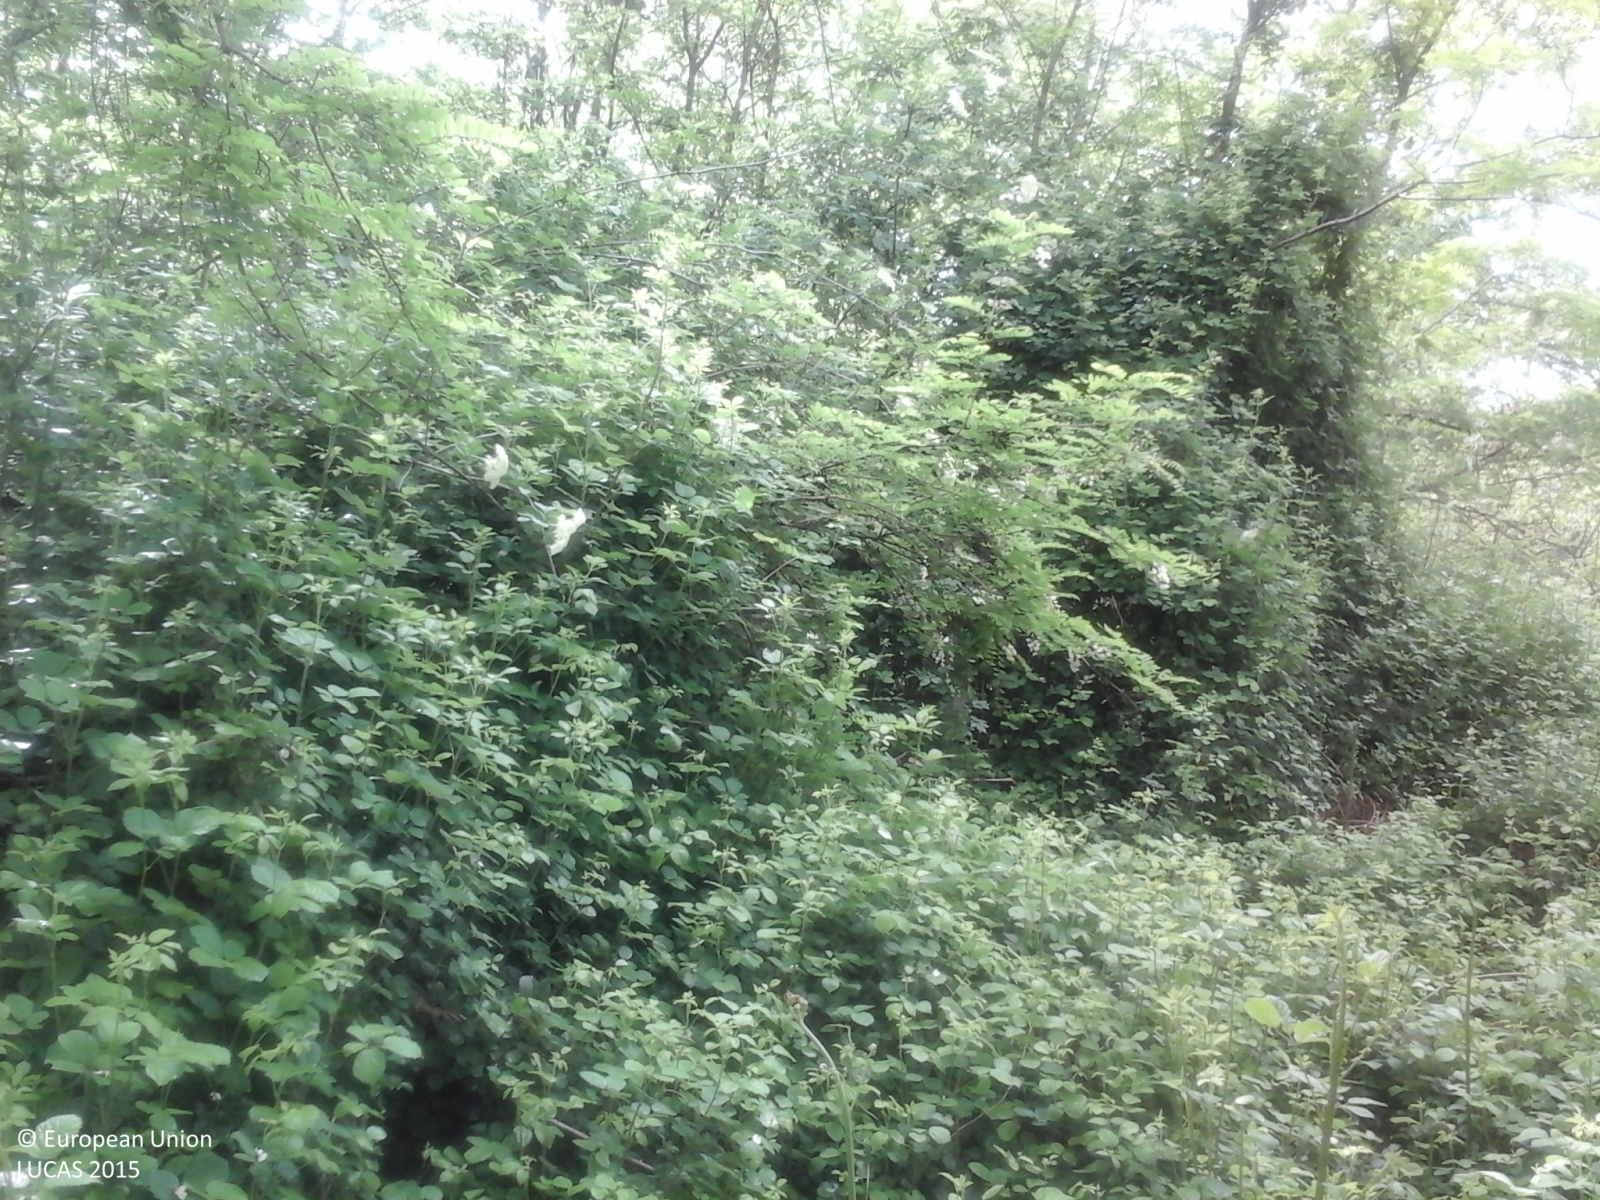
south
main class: Woodland
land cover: Broadleaved woodland
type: thermophilous deciduous forest
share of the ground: > 75 %
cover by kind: broadleaved forest trees 100 %
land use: Forestry
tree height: > 5 m
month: May
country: IT
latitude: 45.7457
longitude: 8.4728
